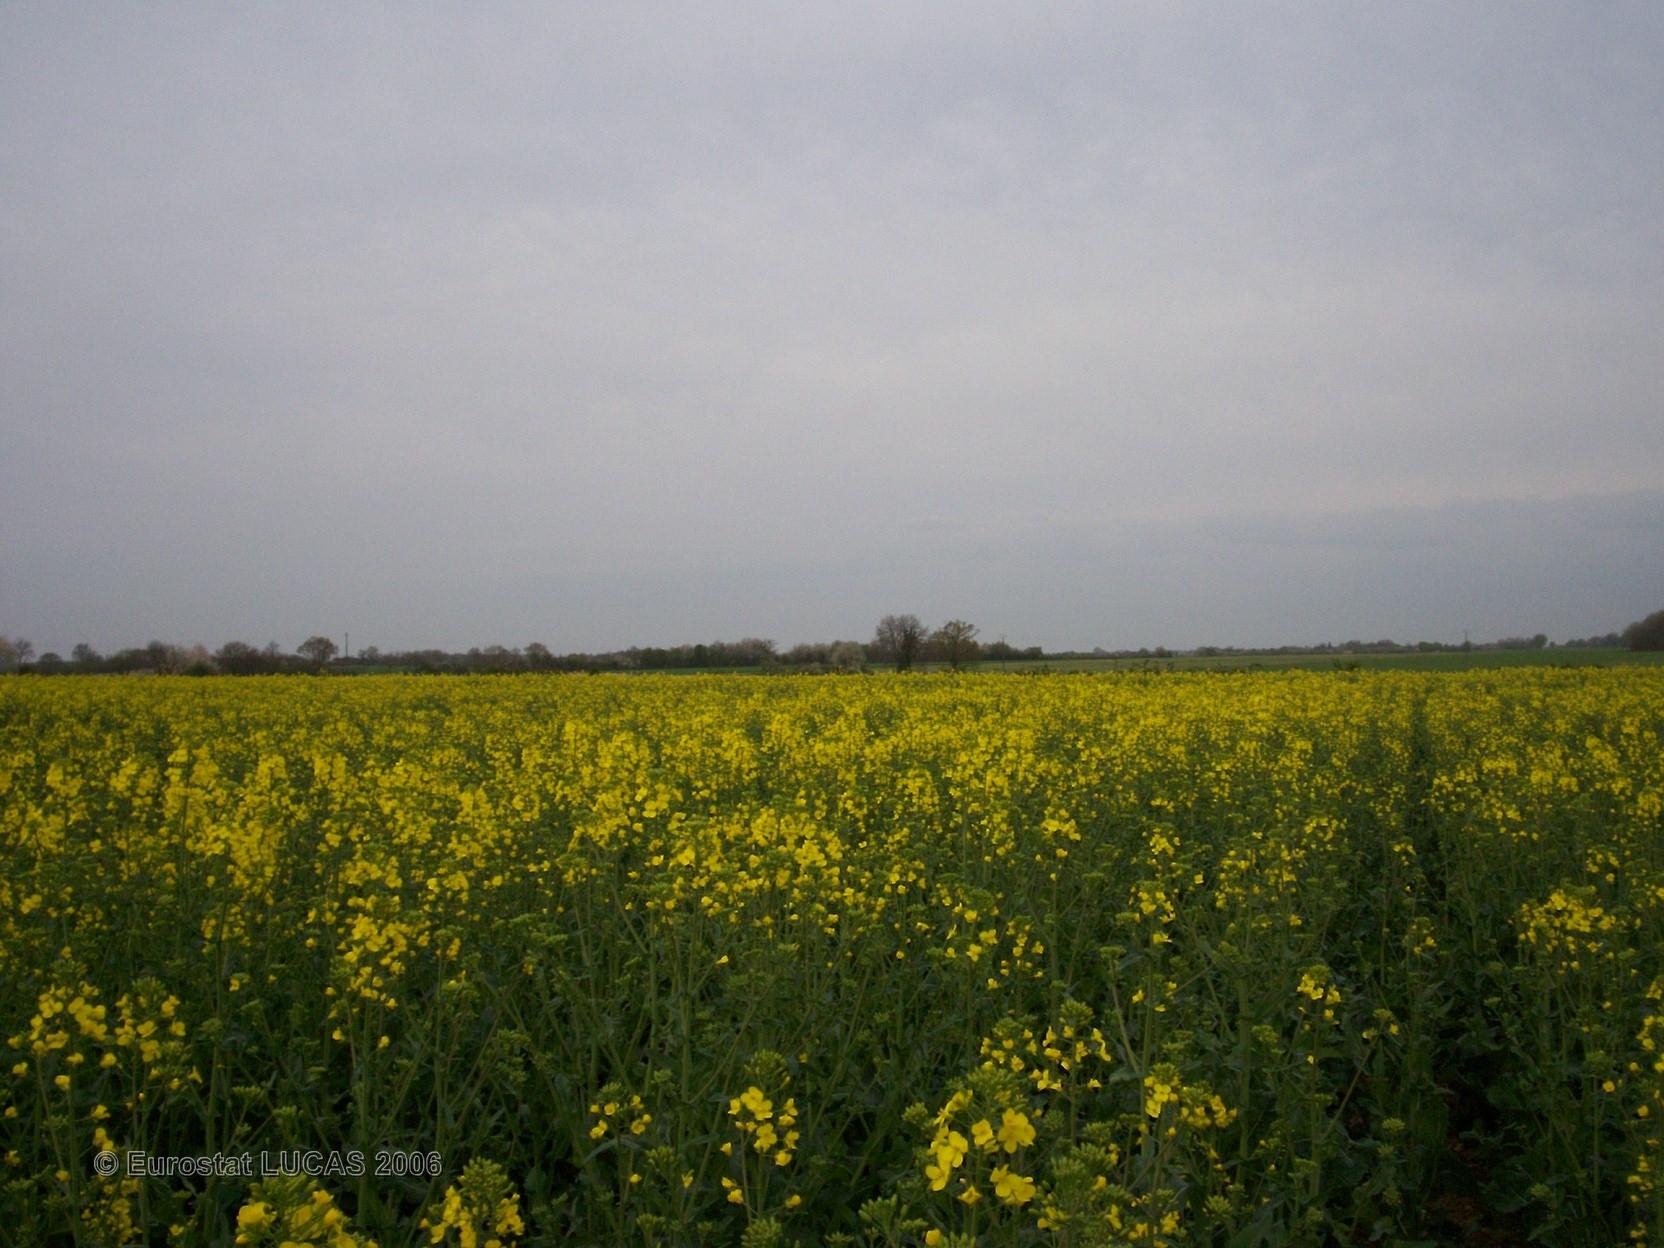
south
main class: Cropland
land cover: Rape and turnip rape
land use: Agriculture (excluding fallow land and kitchen gardens)
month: April
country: FR
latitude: 46.1958
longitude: 0.4593
